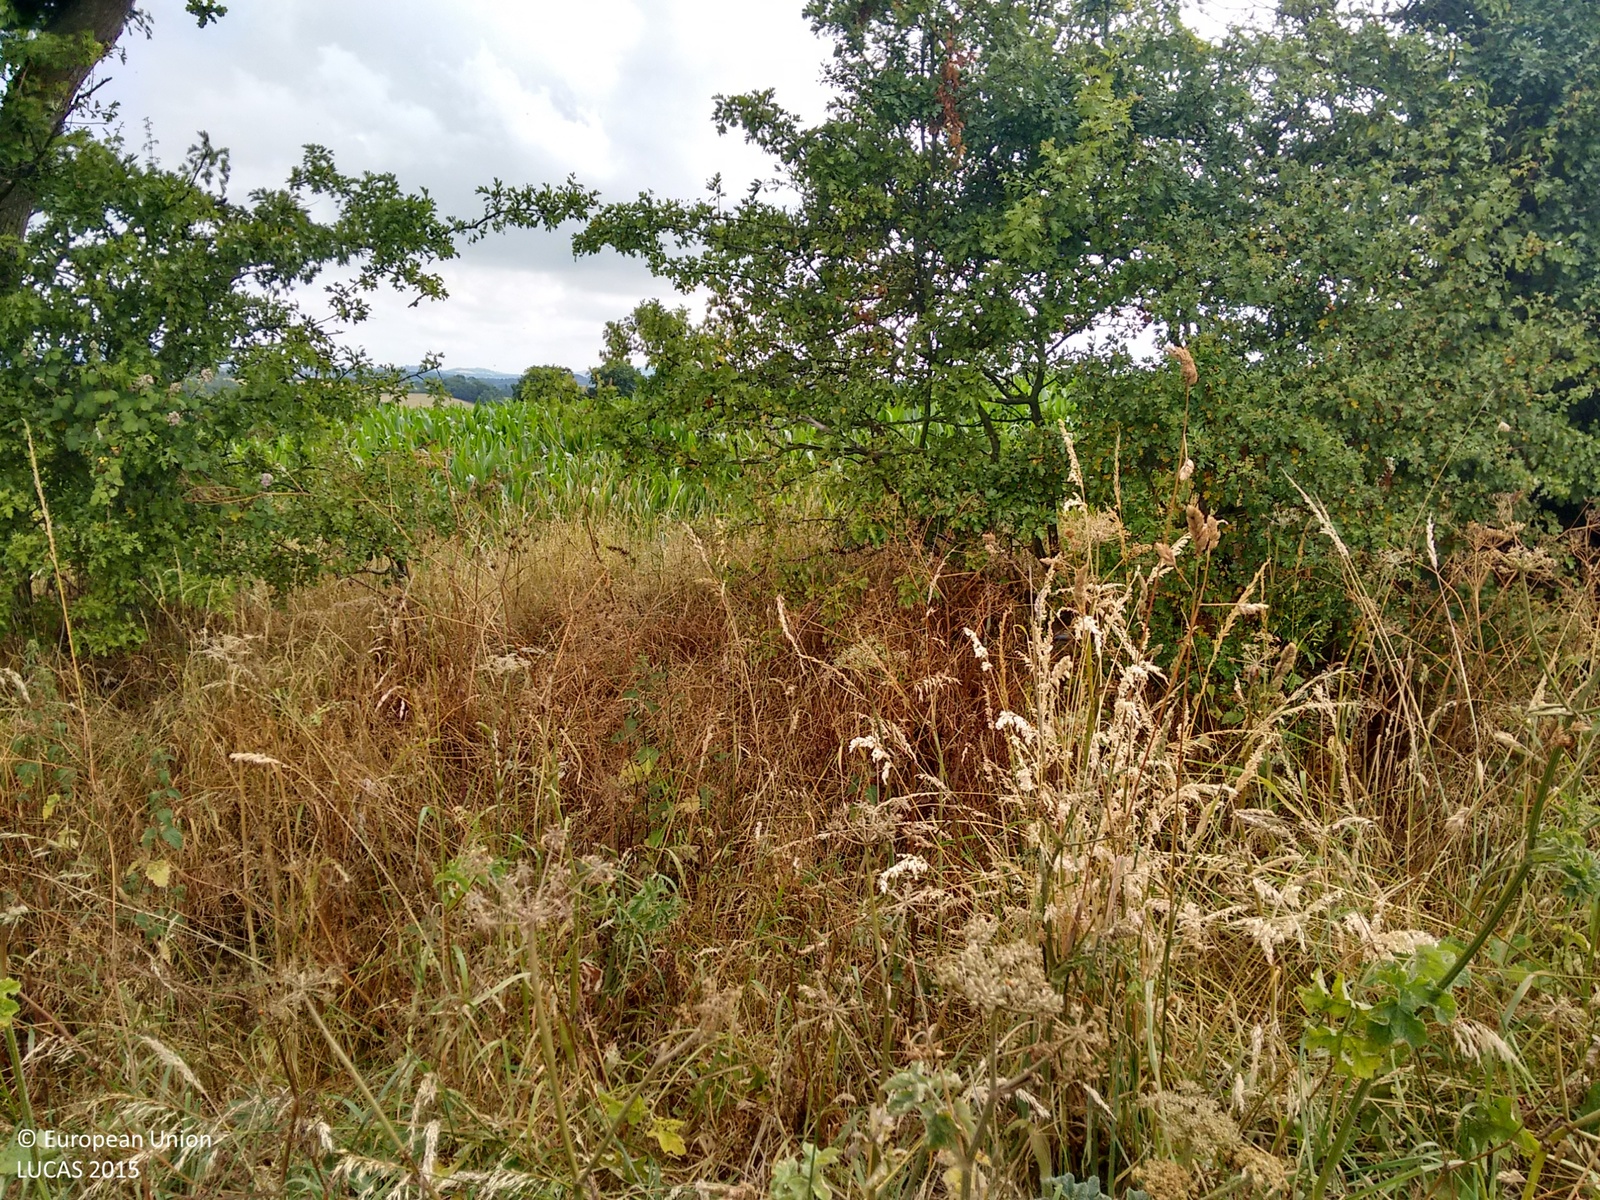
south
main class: Cropland
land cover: Maize
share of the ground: > 75 %
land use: Agriculture (excluding fallow land and kitchen gardens)
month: July
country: GB
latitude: 51.9848
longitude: -2.5163
